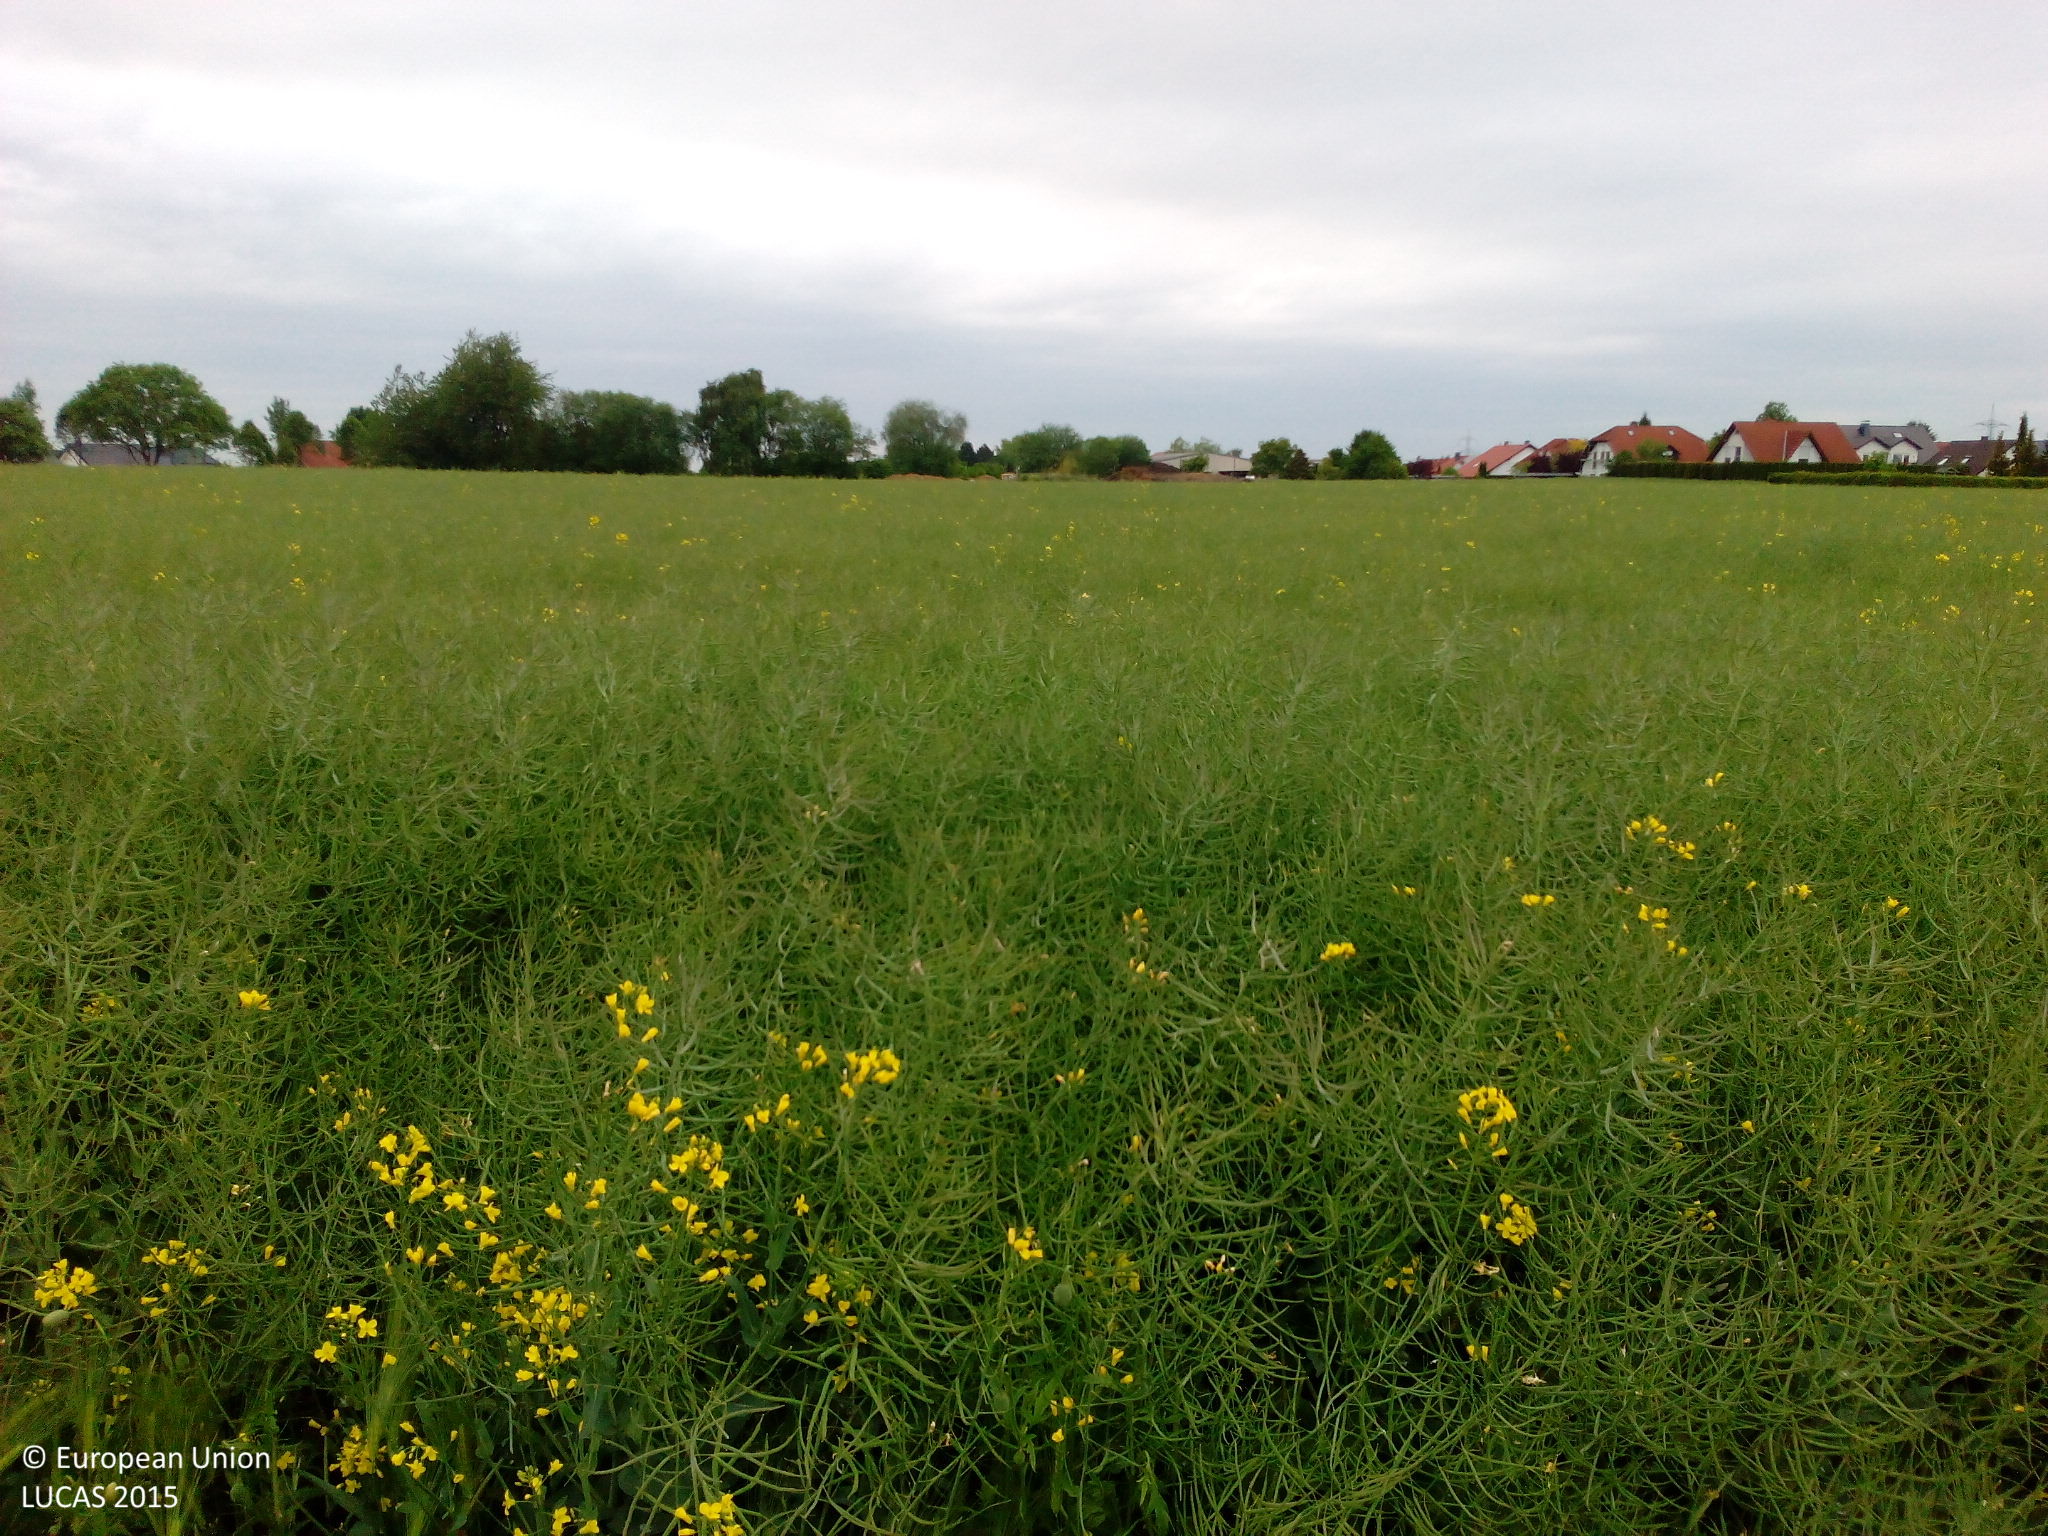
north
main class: Cropland
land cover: Rape and turnip rape
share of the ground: > 75 %
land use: Agriculture (excluding fallow land and kitchen gardens)
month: June
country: DE
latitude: 51.4791
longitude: 7.9701
